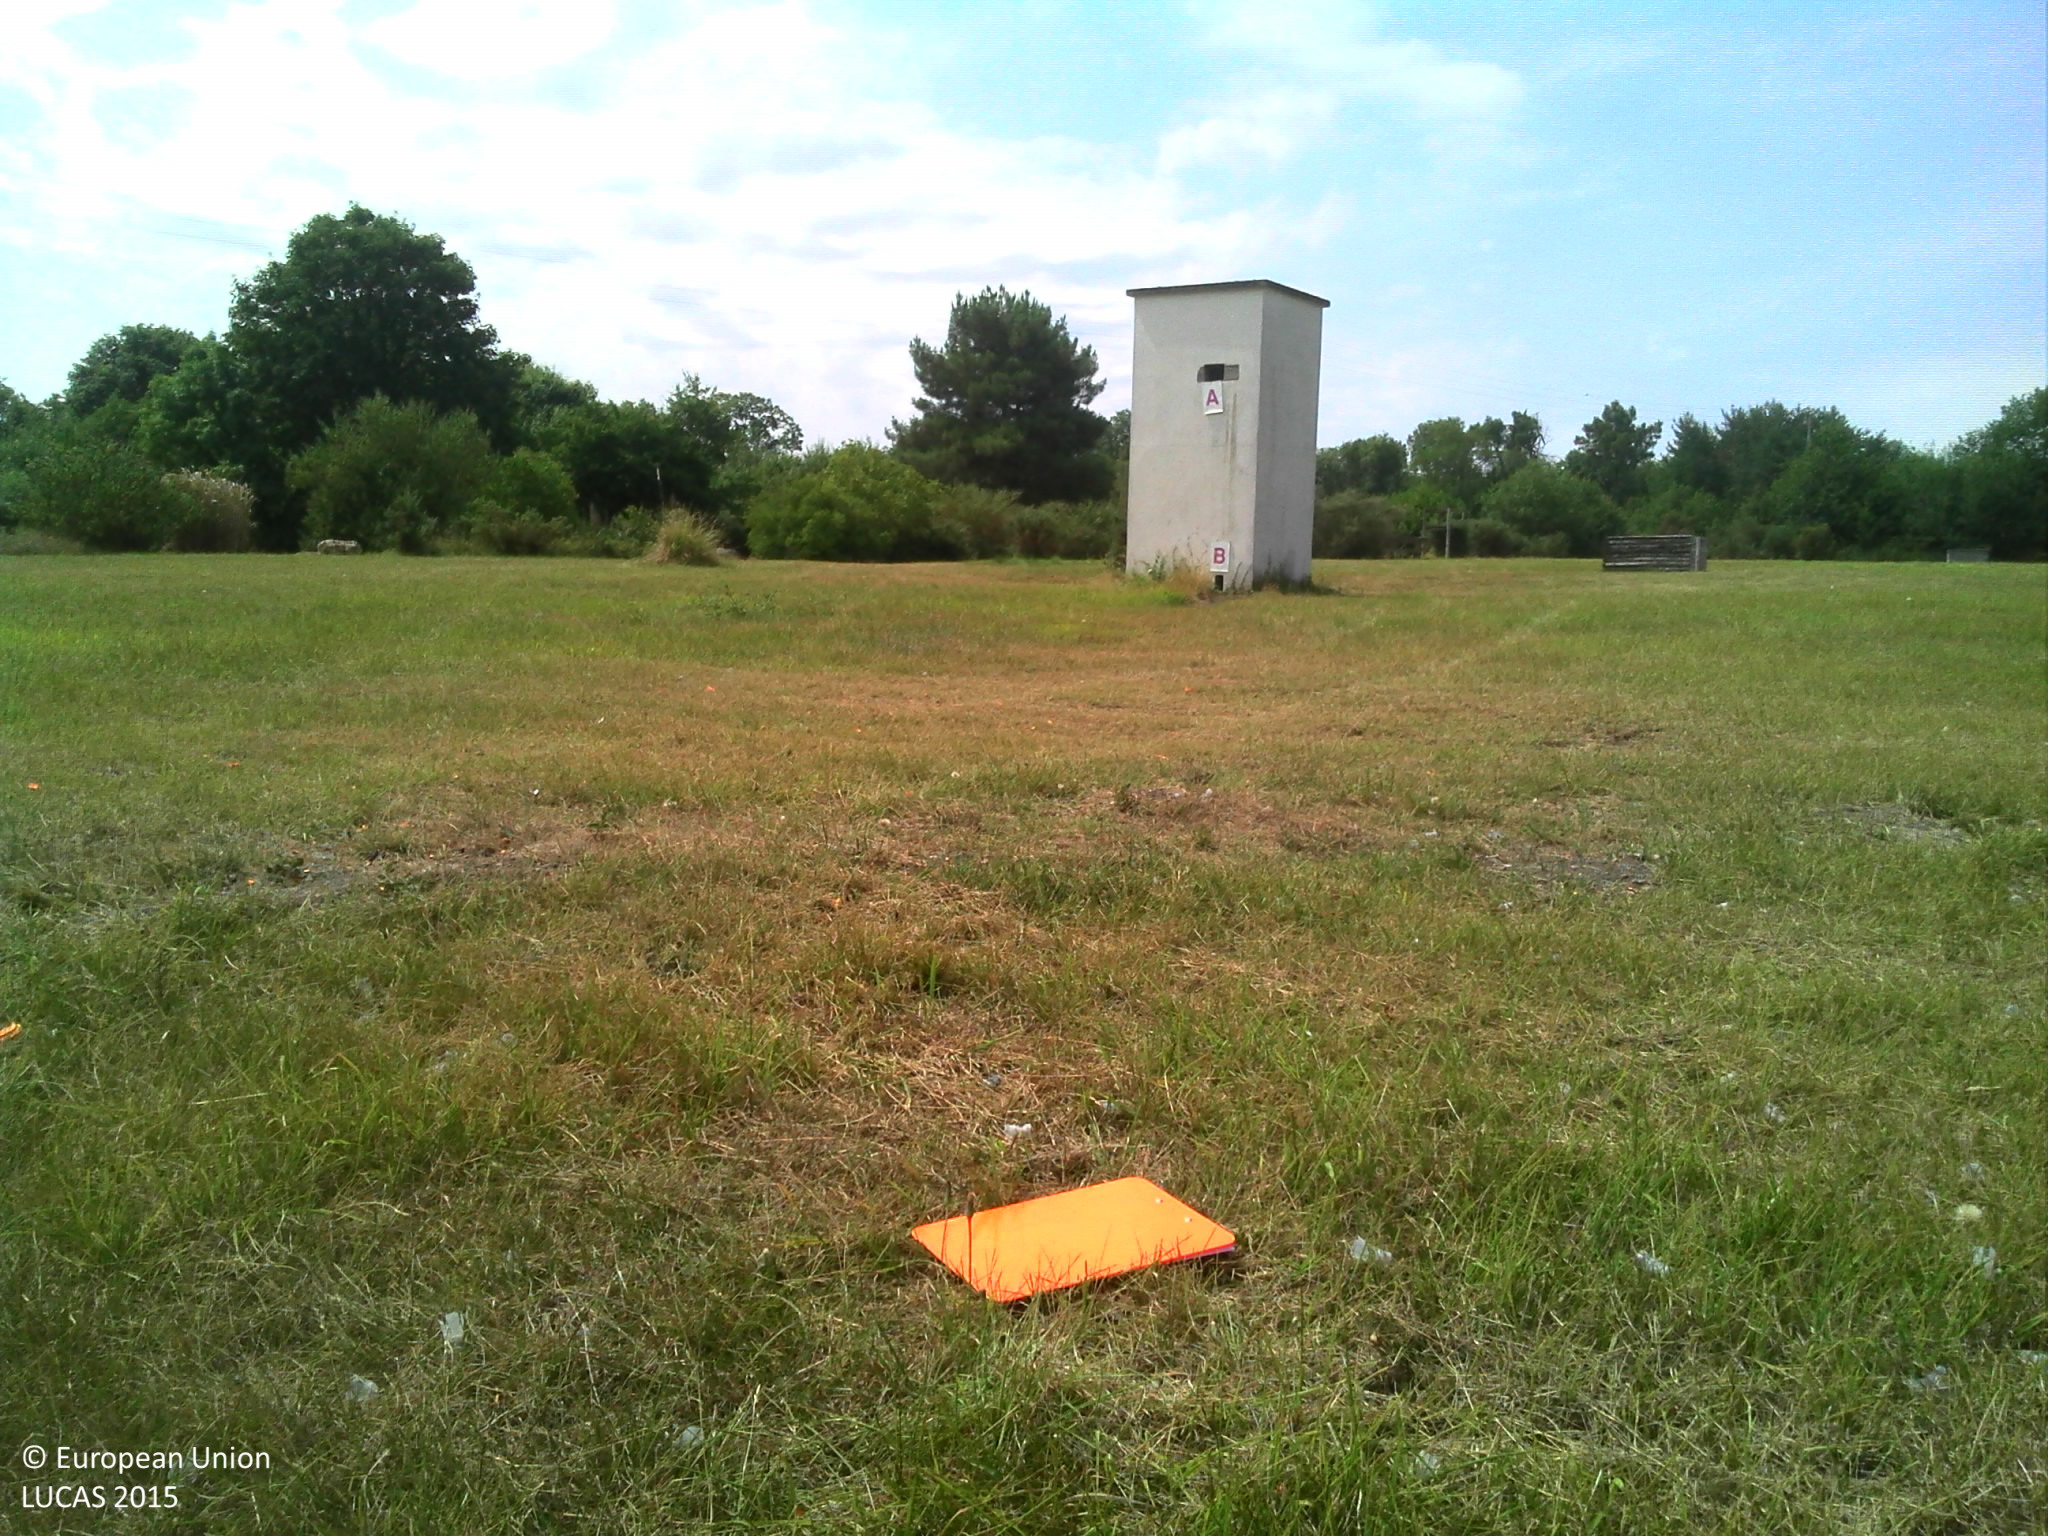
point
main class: Grassland
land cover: Grassland without tree/shrub cover
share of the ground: > 75 %
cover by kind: herbaceous plants 95 %, shrubs 5 %
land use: Sport
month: August
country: FR
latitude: 47.1495
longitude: 0.1785
